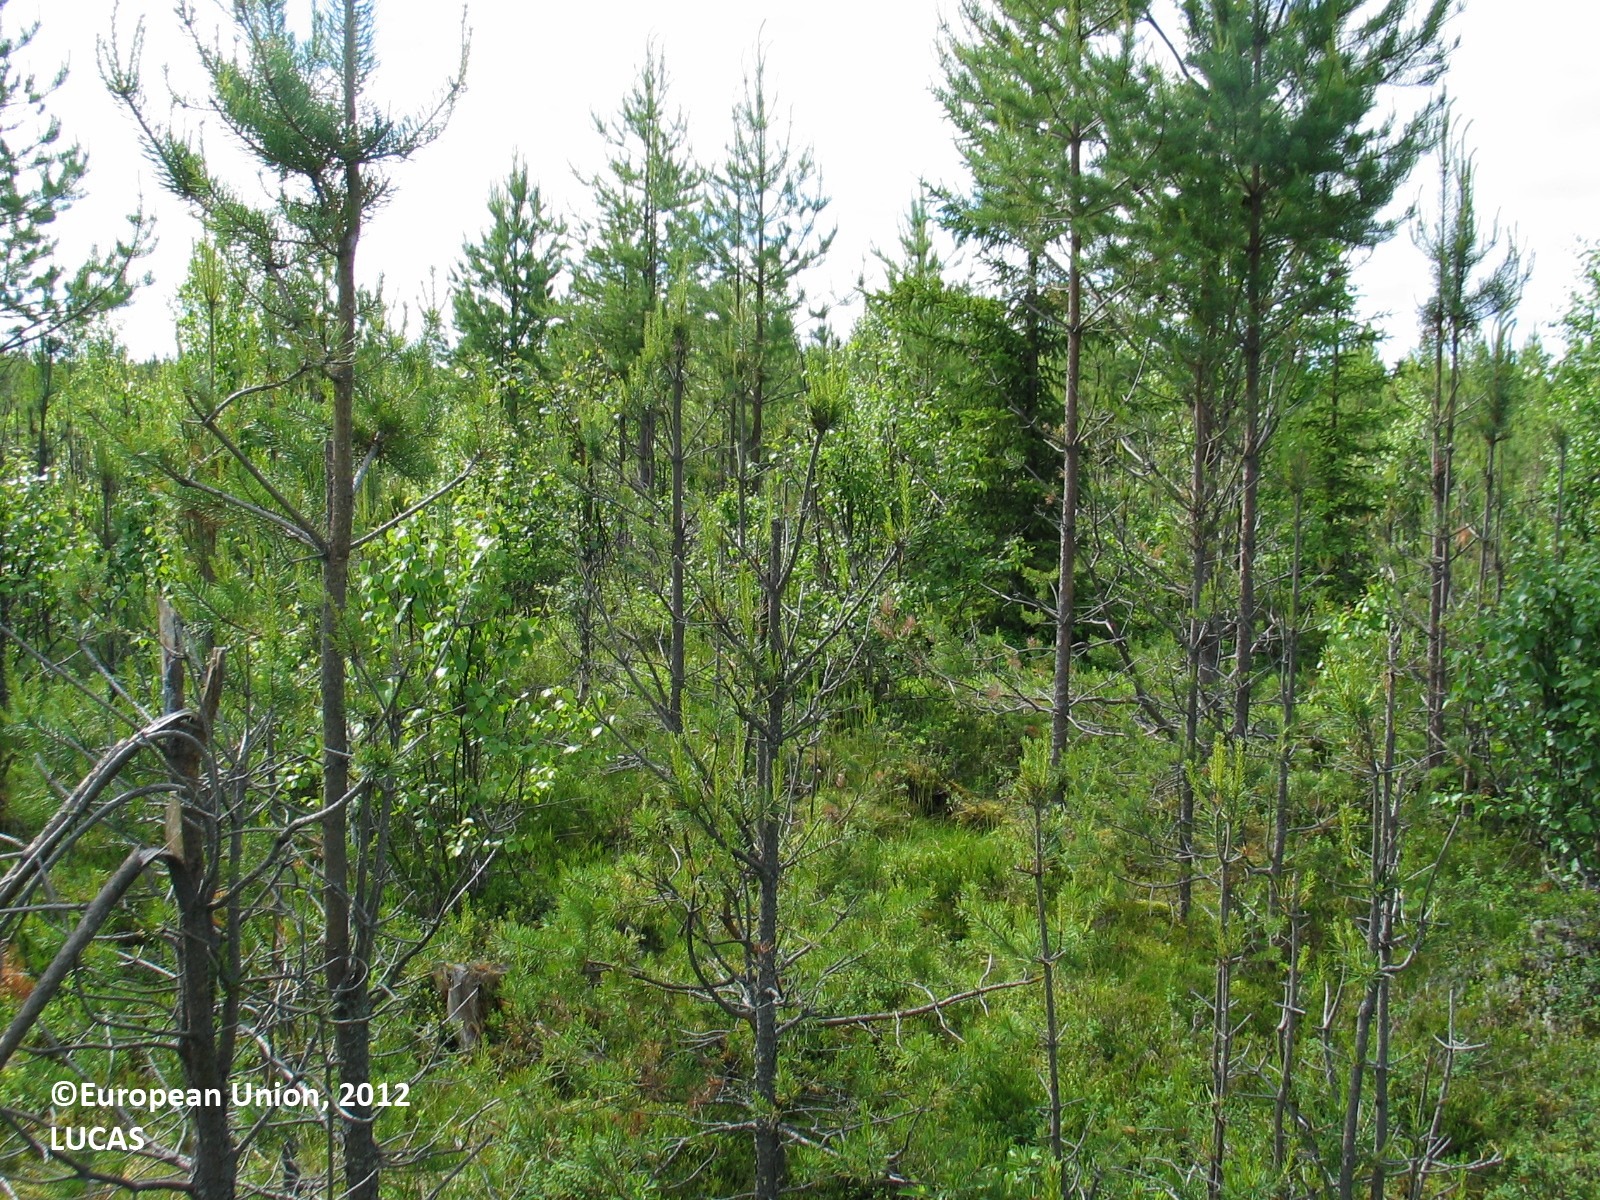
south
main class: Woodland
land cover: Other mixed woodland
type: boreal forest
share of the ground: 25 - 50 %
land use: Forestry
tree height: < 5 m
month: July
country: FI
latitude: 64.7563
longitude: 26.6114
